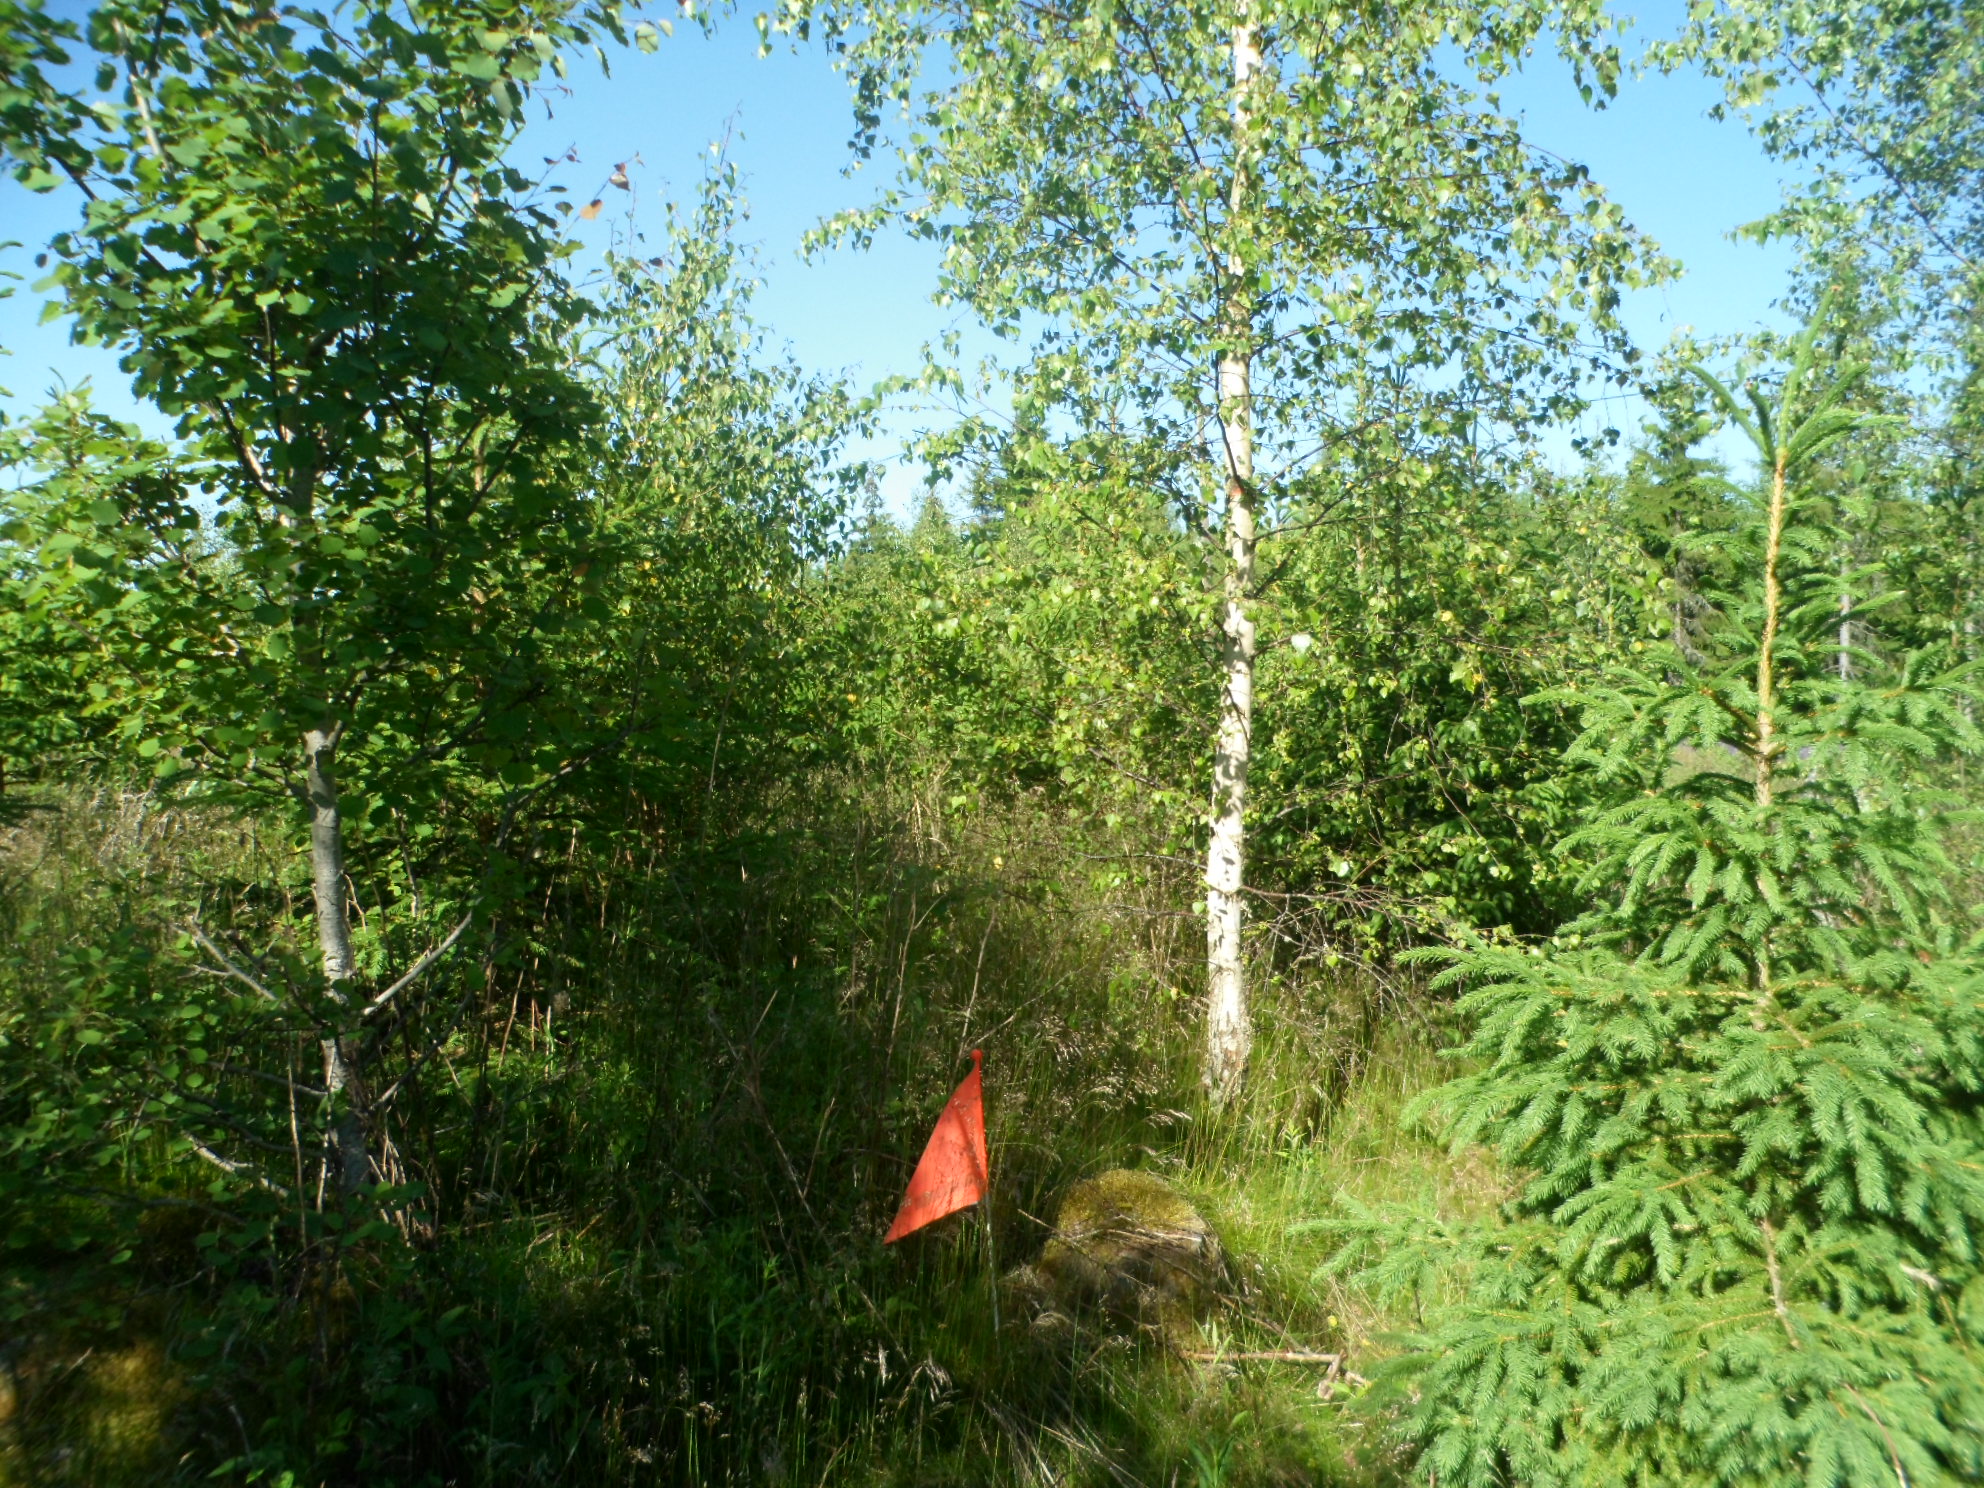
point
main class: Woodland
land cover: Spruce dominated mixed woodland
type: boreal forest
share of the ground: 50 - 75 %
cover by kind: coniferous forest trees 40 %, broadleaved forest trees 35 %, herbaceous plants 15 %, shrubs 5 %, lichens and mosses 5 %
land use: Forestry
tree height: > 5 m
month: July
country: SE
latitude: 57.0600
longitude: 14.5971
